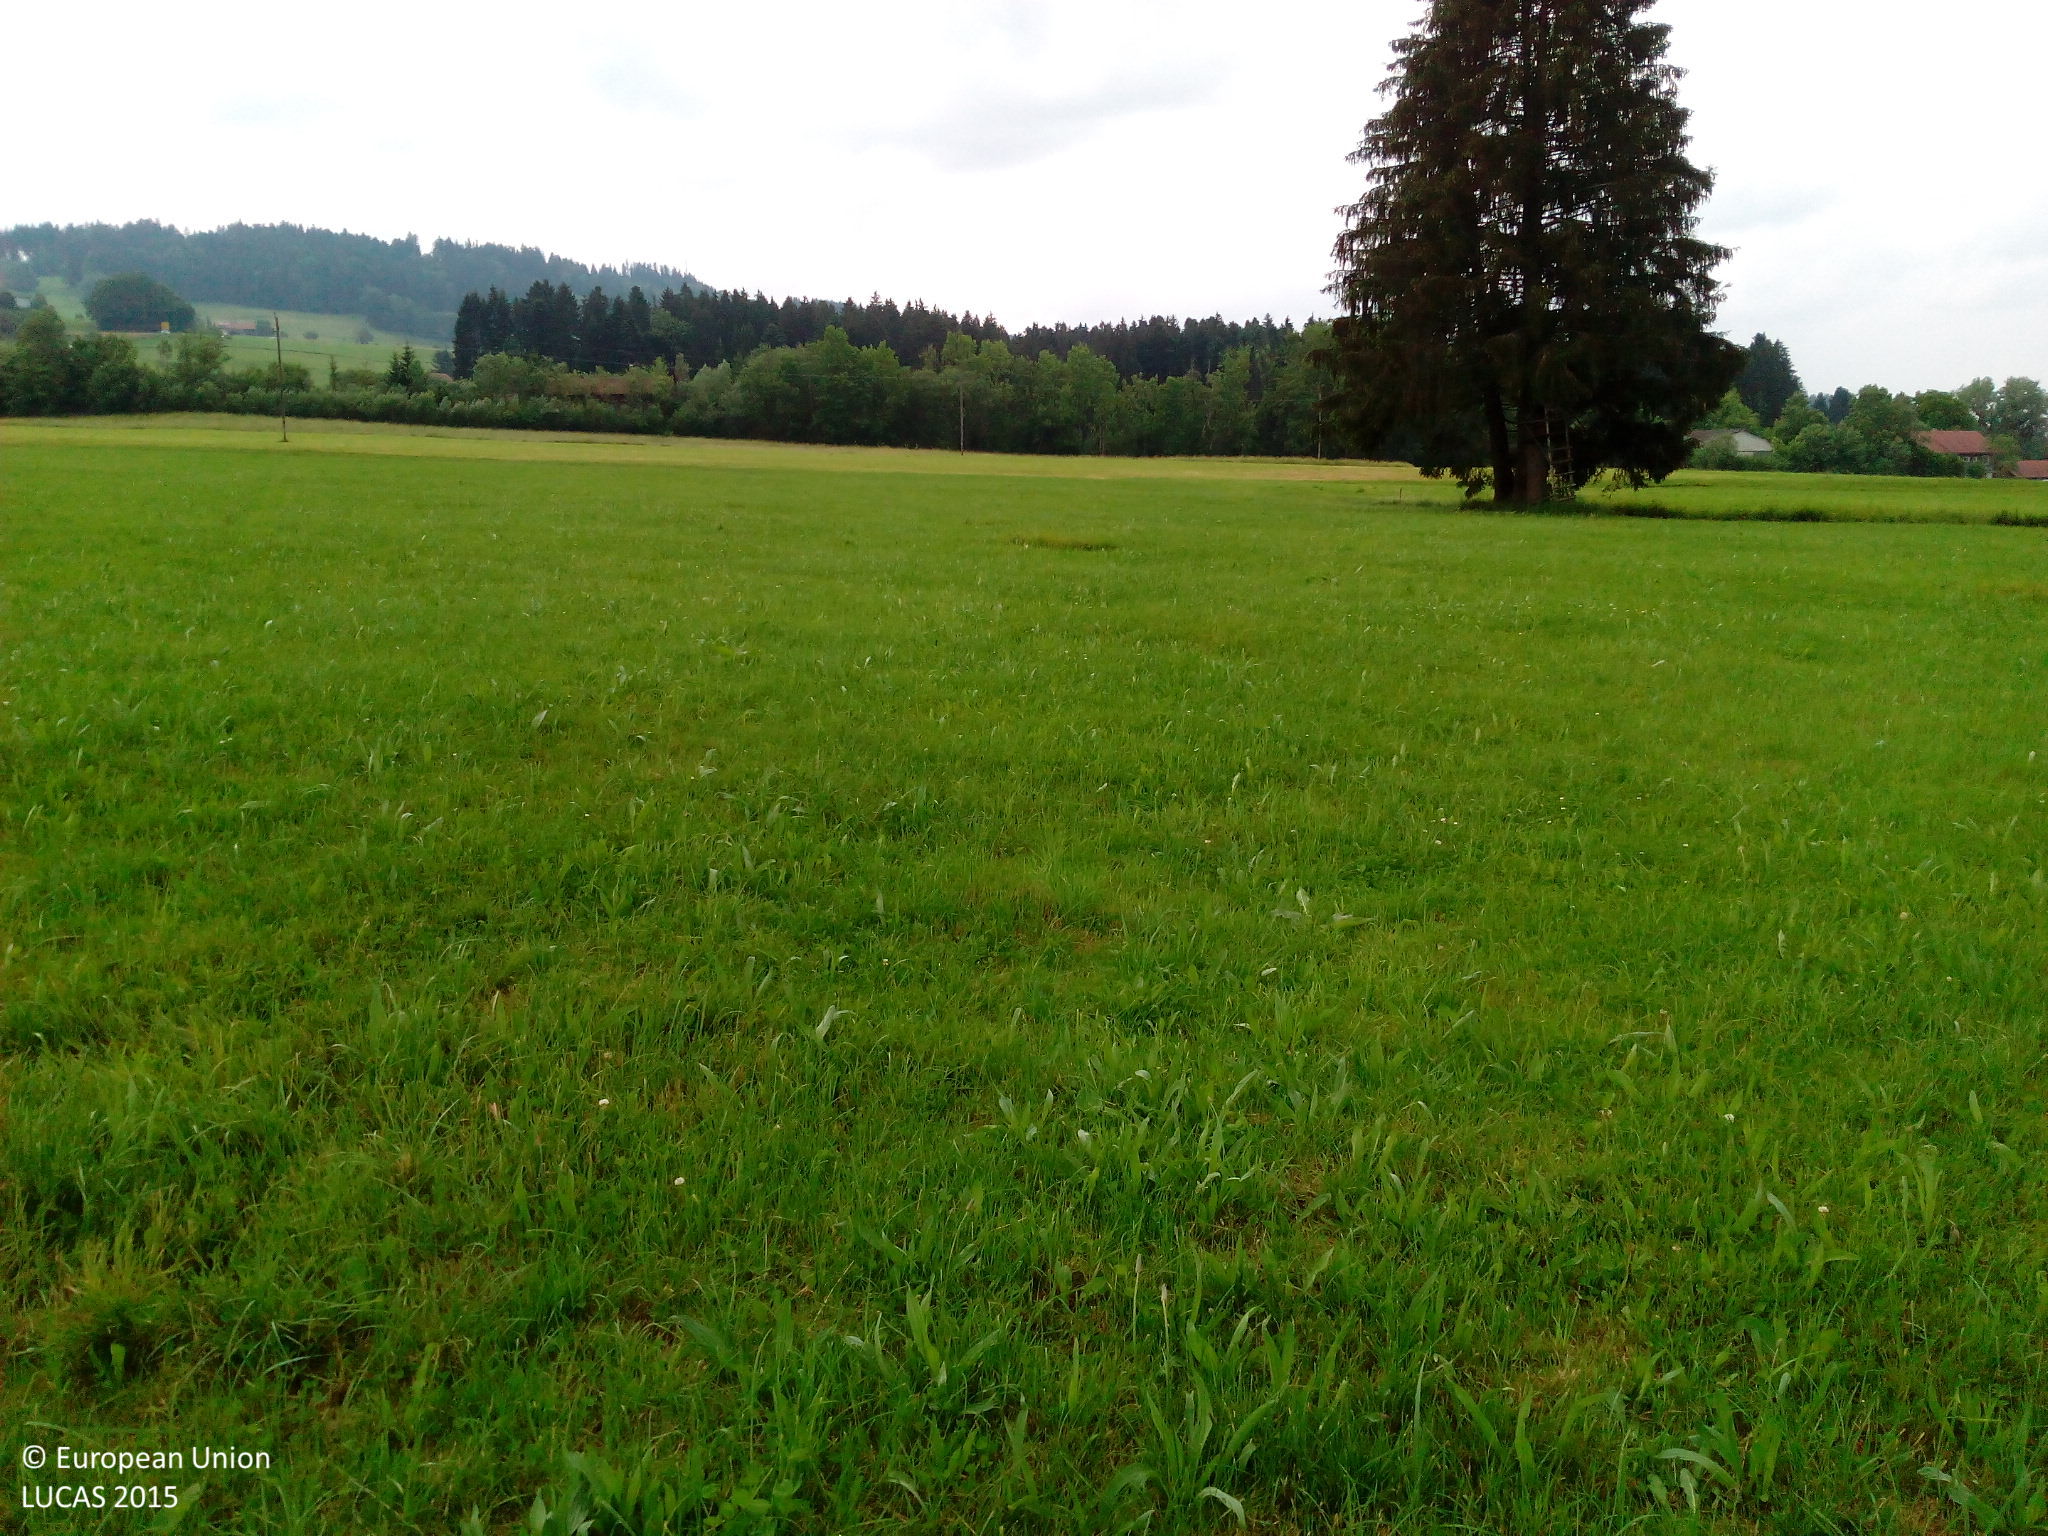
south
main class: Grassland
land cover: Grassland without tree/shrub cover
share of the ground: > 75 %
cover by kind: herbaceous plants 100 %
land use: Agriculture (excluding fallow land and kitchen gardens)
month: June
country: DE
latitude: 47.5936
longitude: 9.9336
